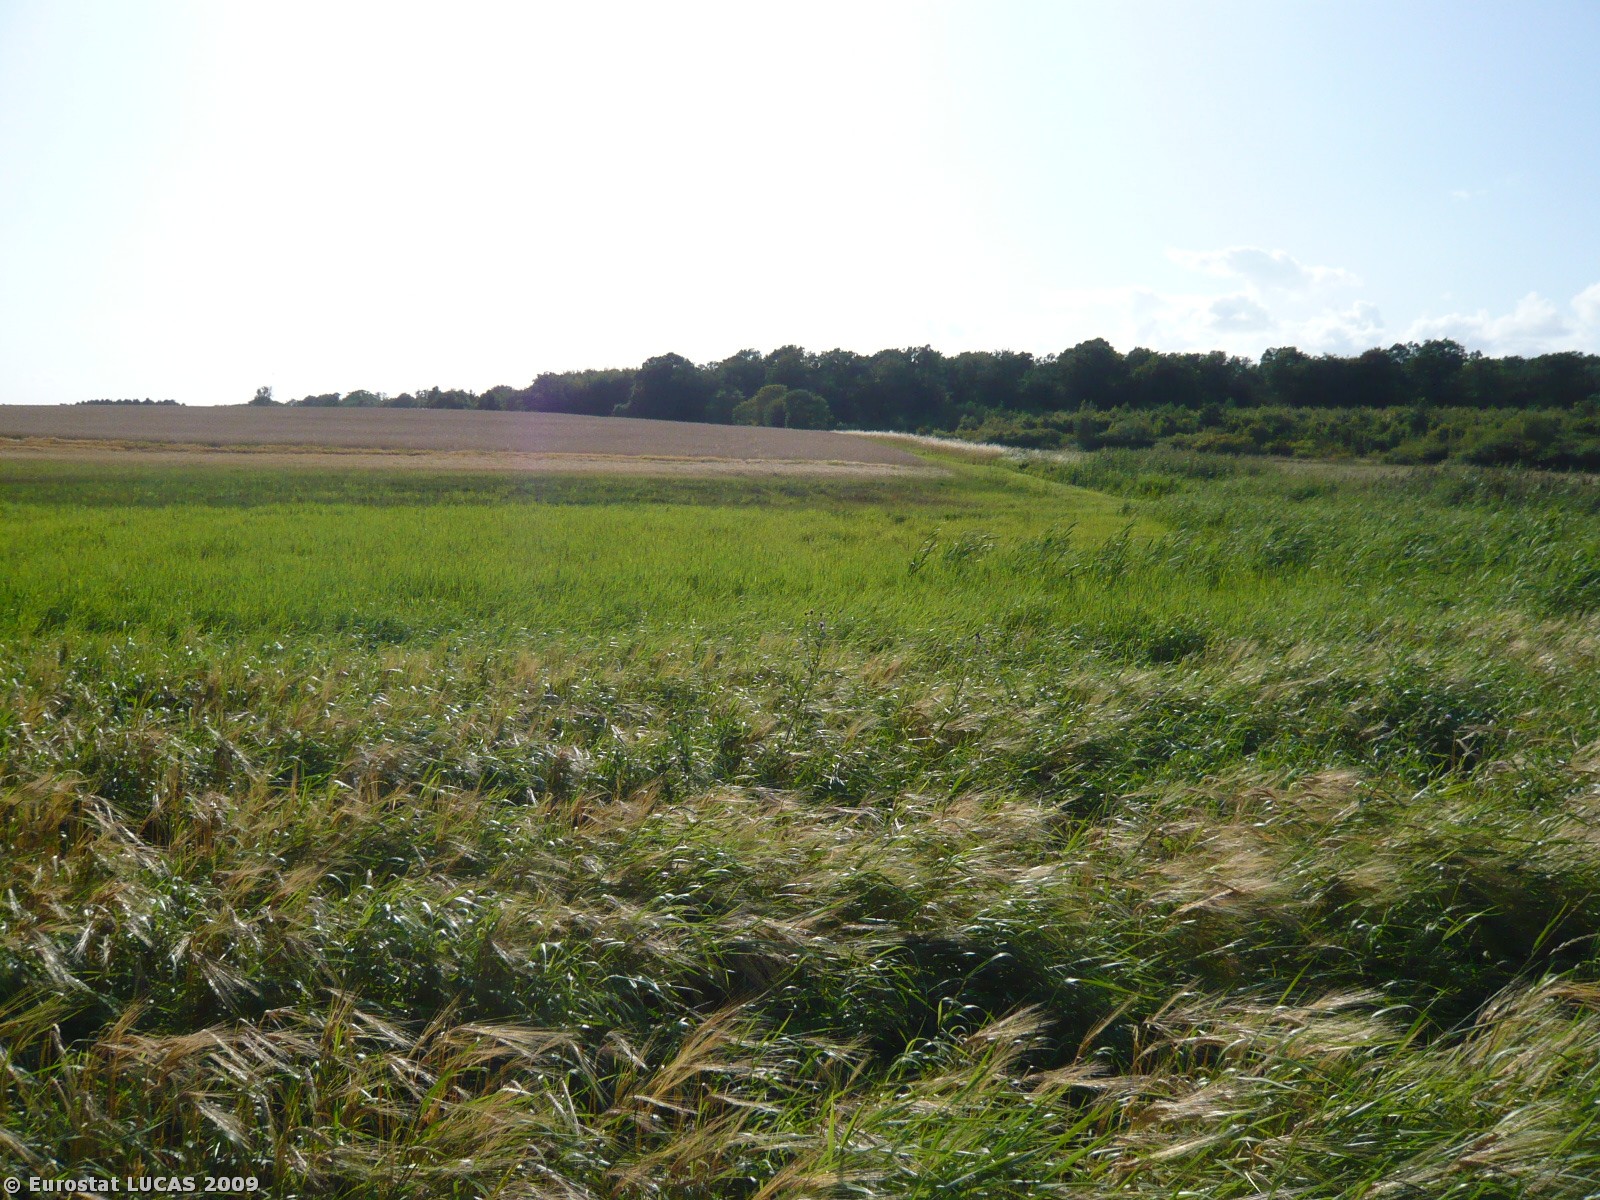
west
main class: Cropland
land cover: Barley
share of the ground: 25 - 50 %
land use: Agriculture (excluding fallow land and kitchen gardens)
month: July
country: DK
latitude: 55.9162
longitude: 12.2539
